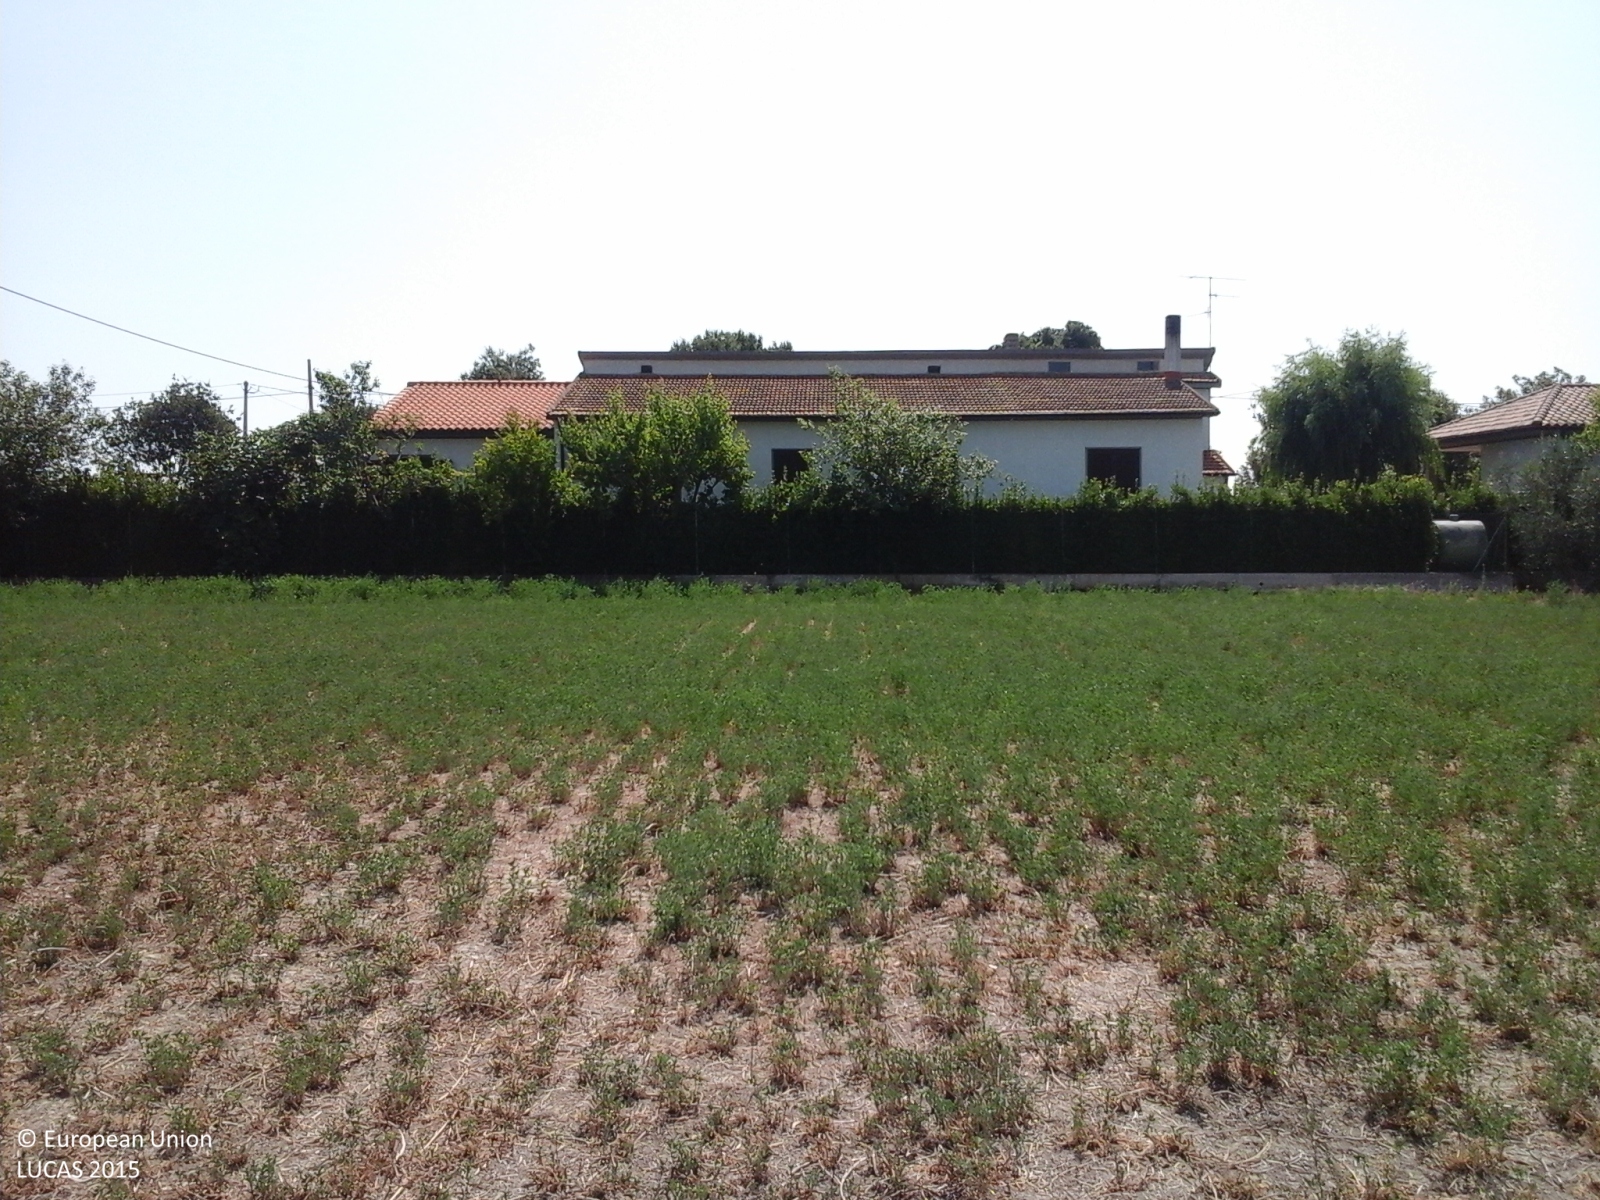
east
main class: Cropland
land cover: Lucerne
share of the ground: > 75 %
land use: Agriculture (excluding fallow land and kitchen gardens)
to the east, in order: Lucerne; Fences; Abandoned hedges; Artificial constructions in urban areas; Abandoned hedges; Fences; Electric lines; Paved roads, cycling and walking lanes; Ditches and canals; Fences; Abandoned hedges; Olive groves; Grassland with sparse tree/shrub cover; Electric lines; Olive groves; Other fresh vegetables; Olive groves; Fences; Grass margins; Tracks; Lines of trees; Artificial constructions in urban areas; Grassland with sparse tree/shrub cover; Fences; Other bare soil
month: July
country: IT
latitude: 42.7571
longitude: 11.0352
